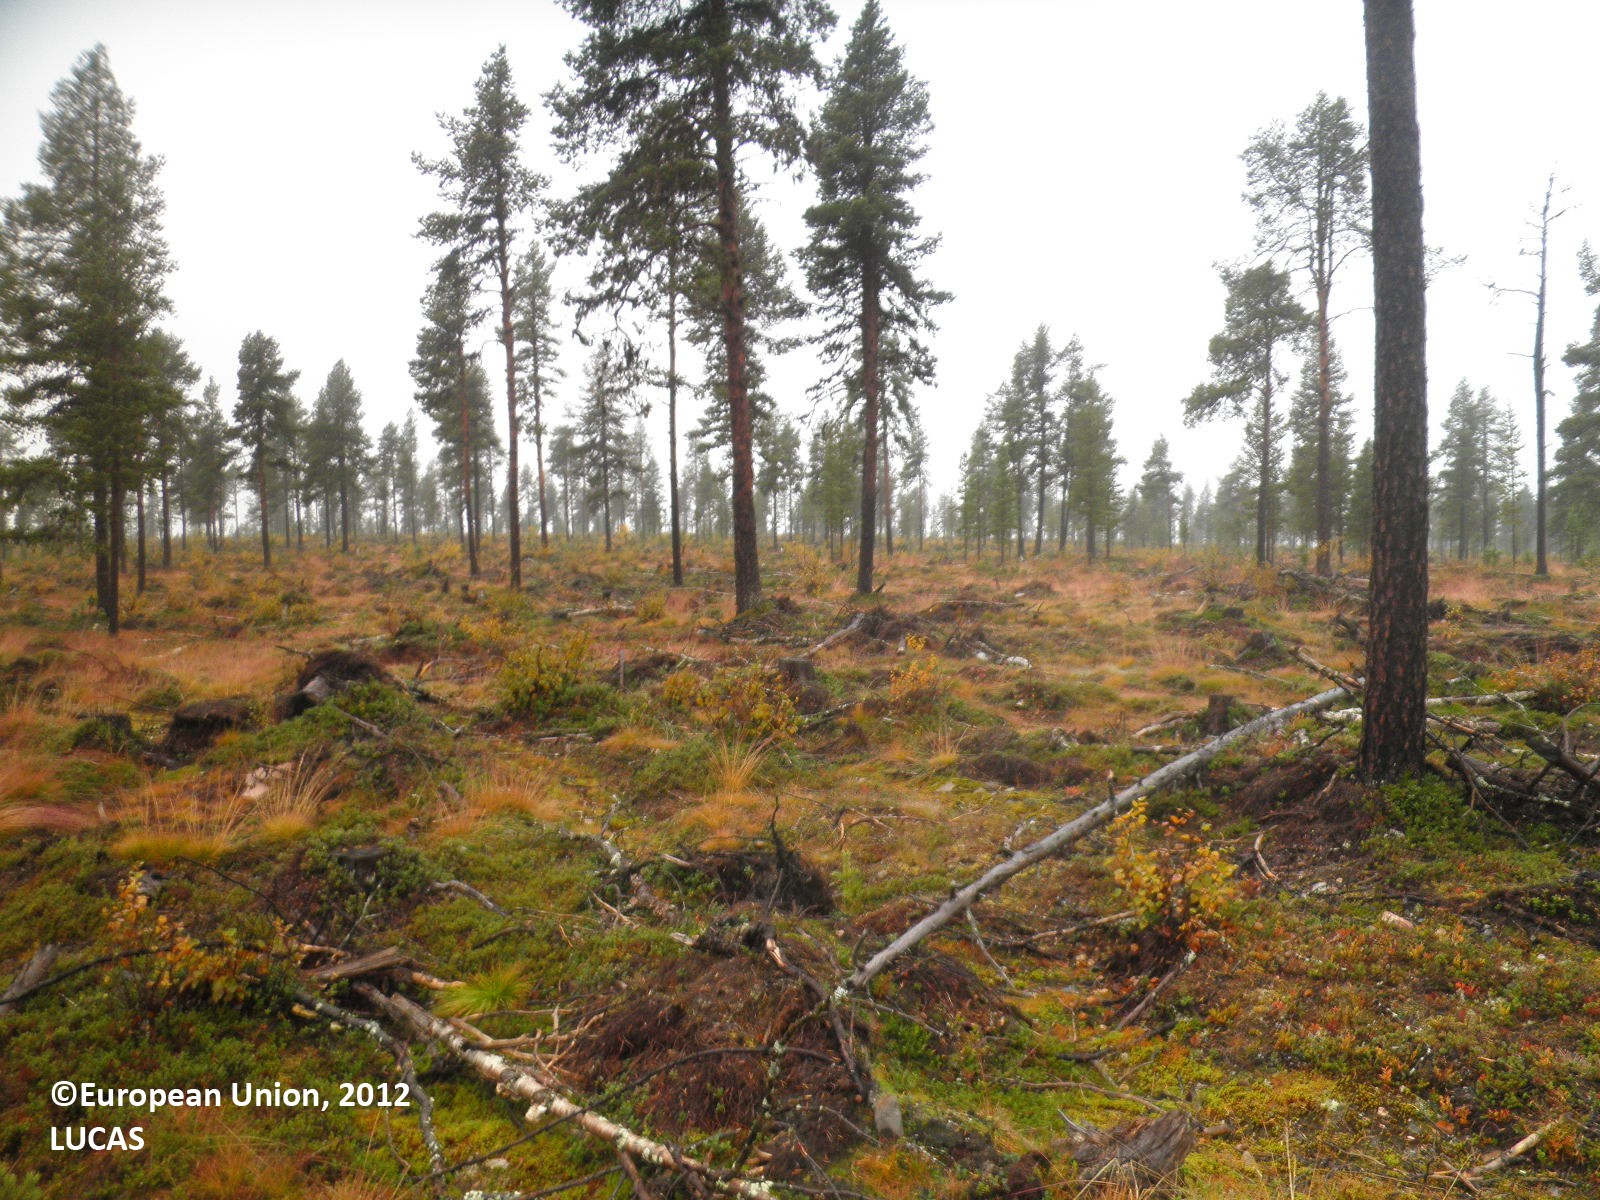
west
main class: Woodland
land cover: Pine dominated coniferous woodland
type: boreal forest
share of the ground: 10 - 25 %
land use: Forestry
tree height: > 5 m
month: September
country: FI
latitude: 68.4387
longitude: 22.7965
